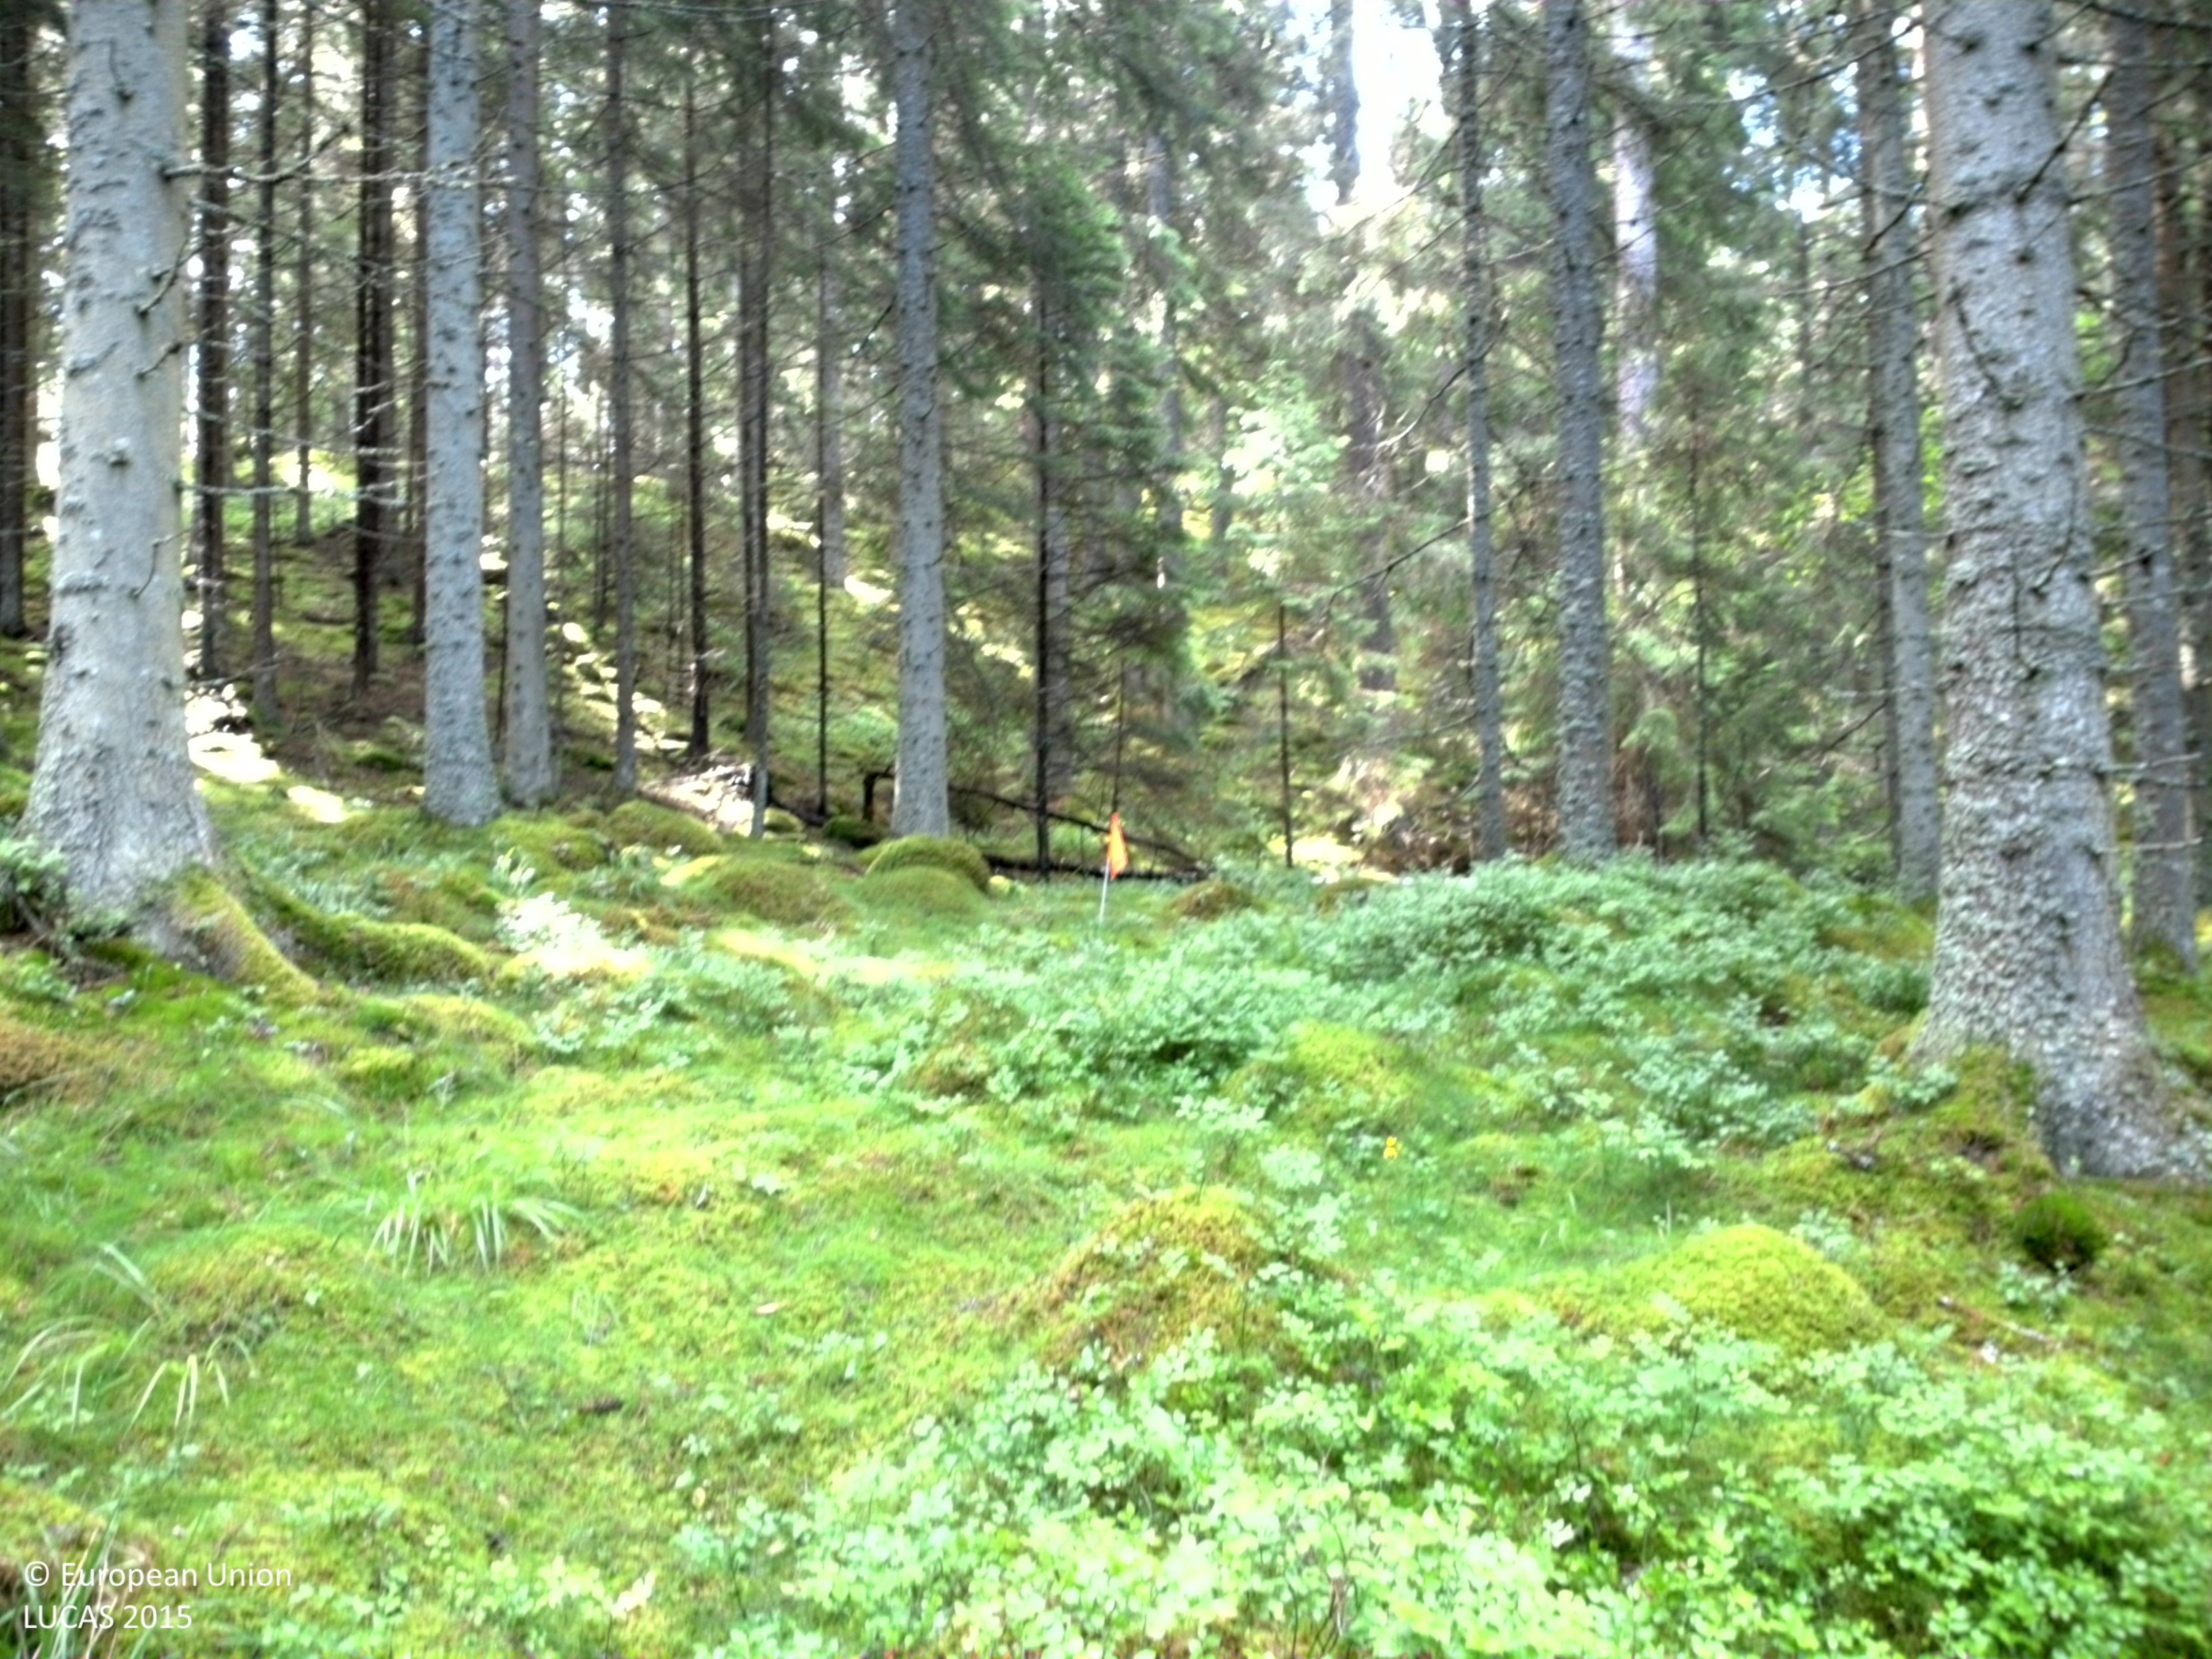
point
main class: Woodland
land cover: Spruce dominated coniferous woodland
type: boreal forest
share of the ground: 25 - 50 %
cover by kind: coniferous forest trees 40 %, lichens and mosses 35 %, herbaceous plants 25 %
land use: Forestry
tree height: > 5 m
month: July
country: SE
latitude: 58.7460
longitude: 15.7481
